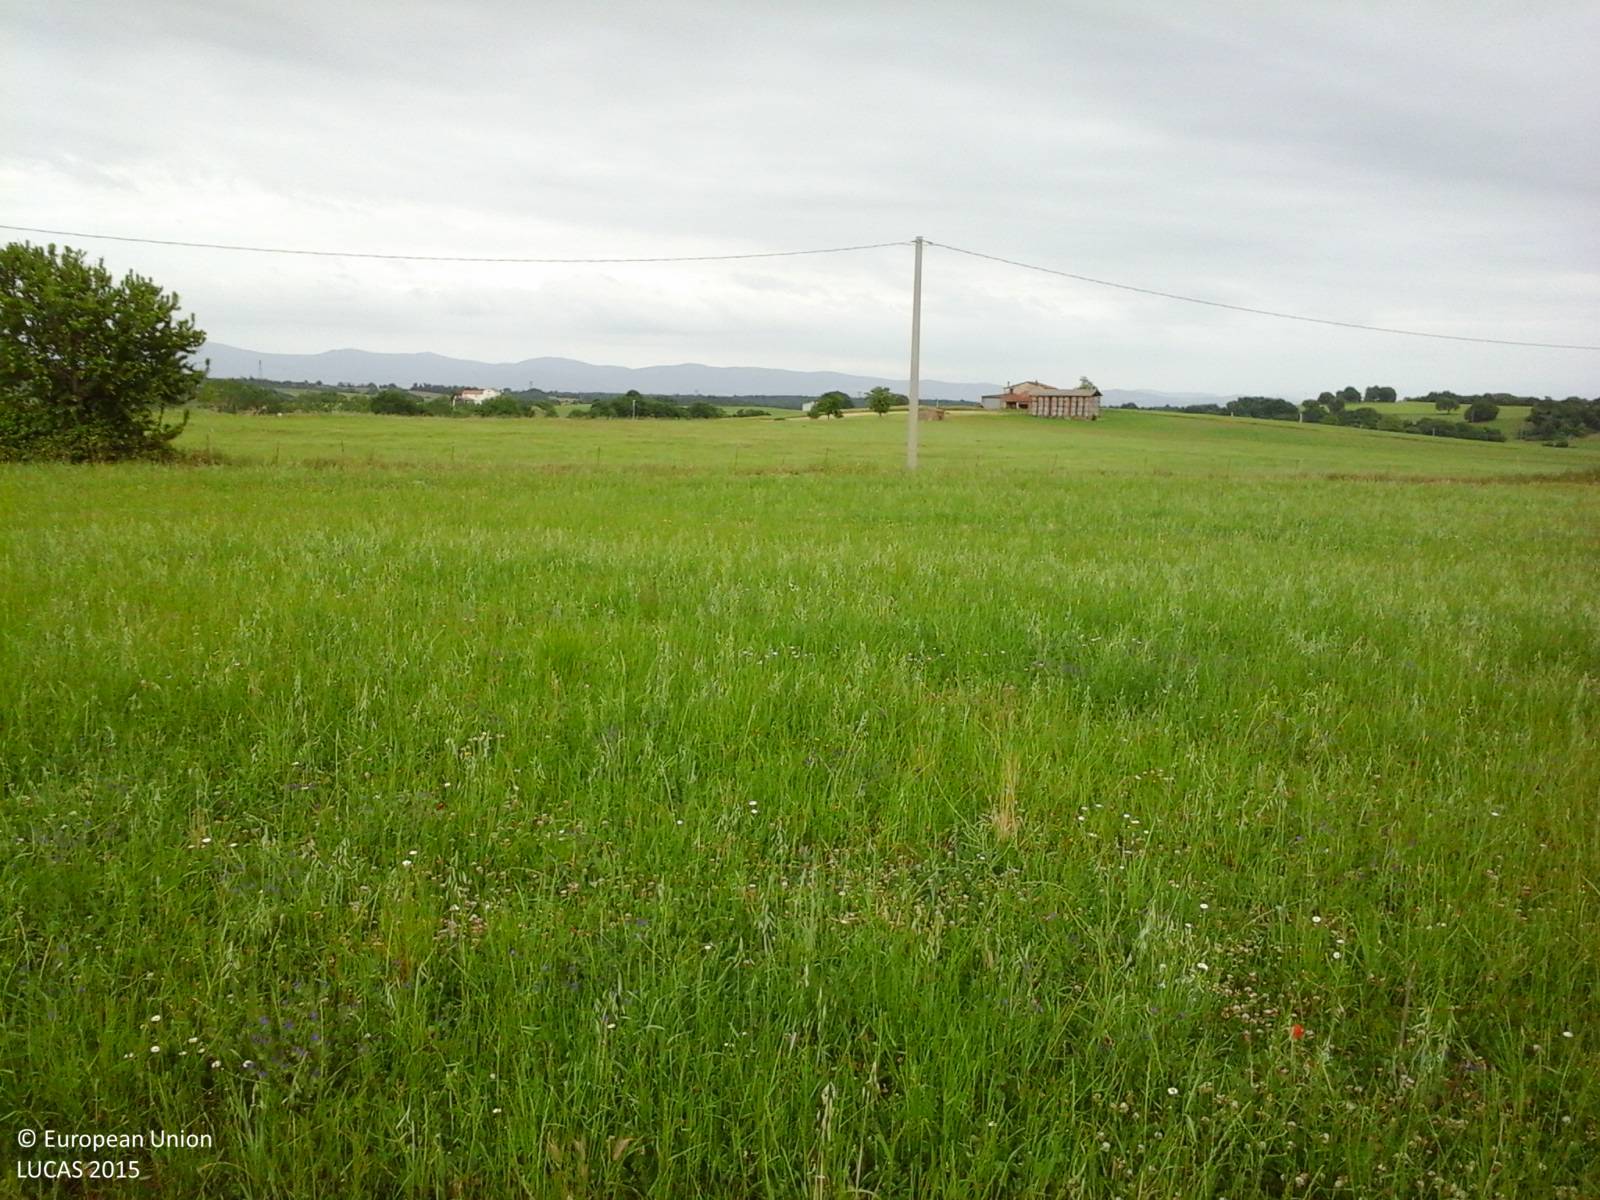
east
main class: Cropland
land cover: Other leguminous and mixtures for fodder
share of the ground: > 75 %
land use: Agriculture (excluding fallow land and kitchen gardens)
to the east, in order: Other leguminous and mixtures for fodder; Fences; Tracks; Fences; Other leguminous and mixtures for fodder
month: May
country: IT
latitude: 42.5239
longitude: 12.0989
